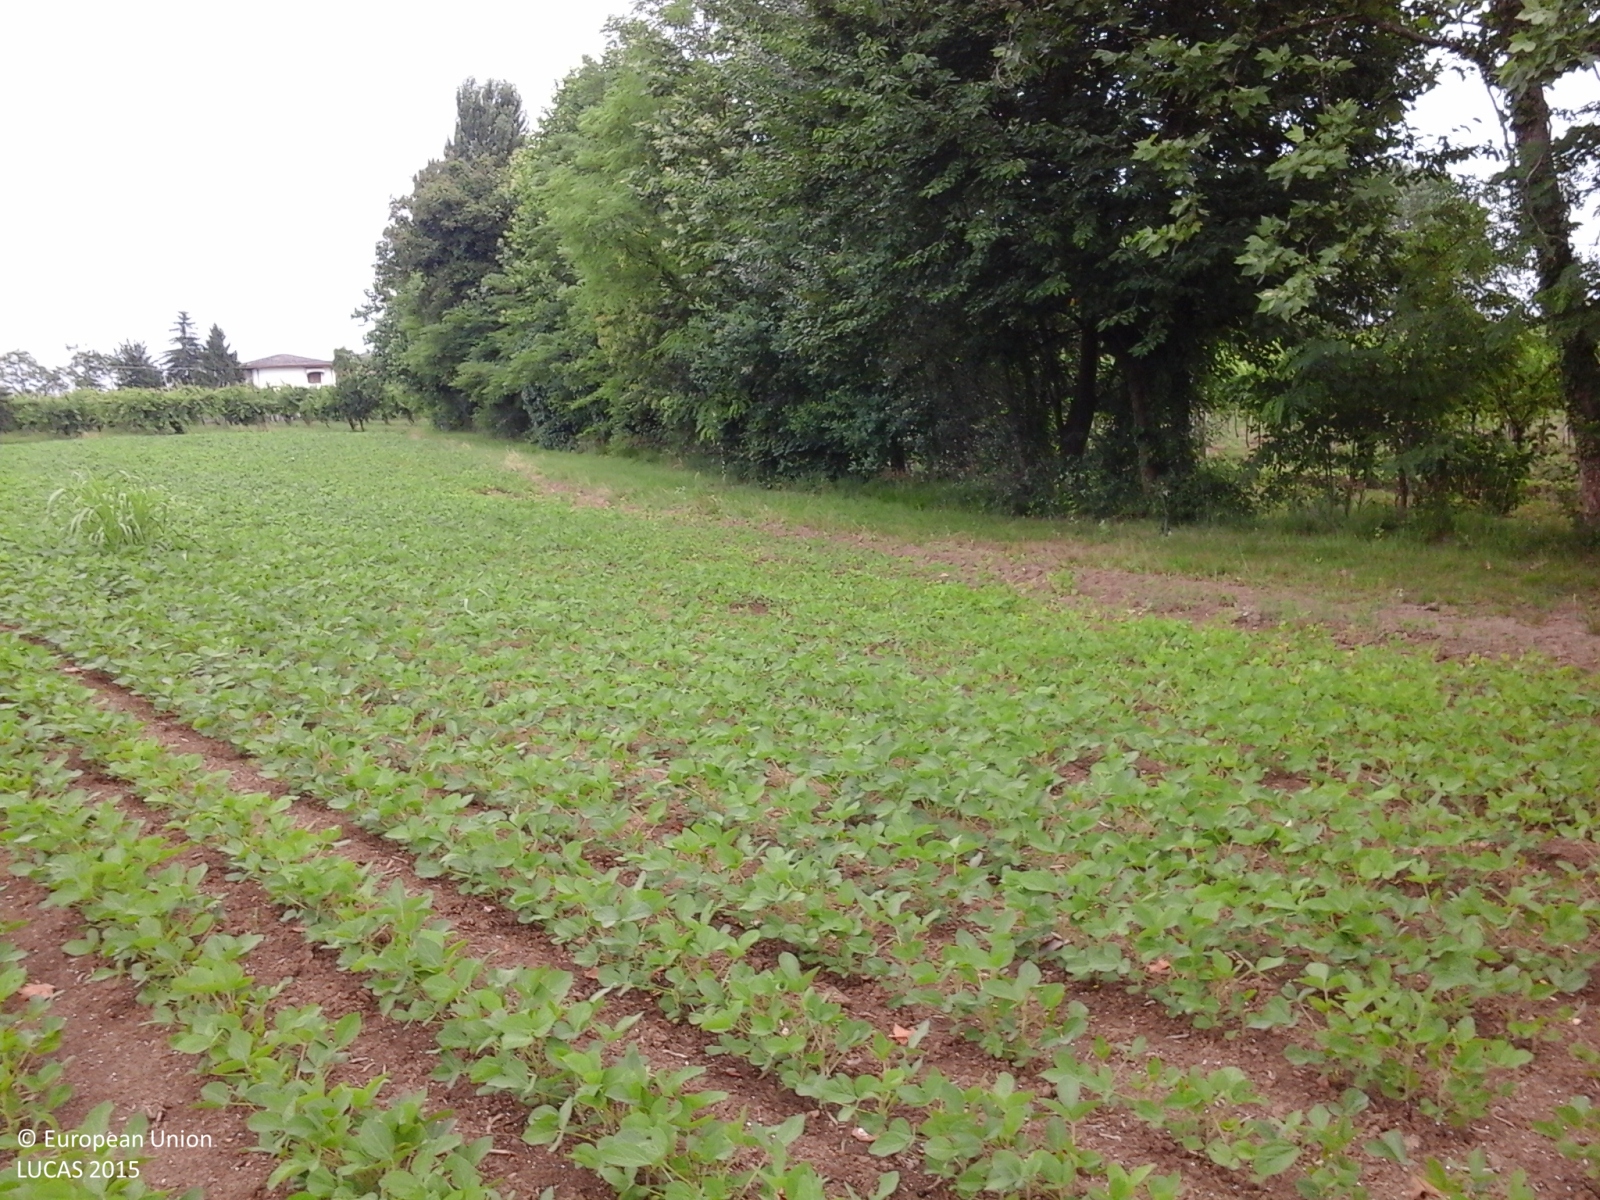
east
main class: Cropland
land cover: Soya
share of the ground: 50 - 75 %
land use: Agriculture (excluding fallow land and kitchen gardens)
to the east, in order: Soya; Grass margins; Abandoned hedges; Ditches and canals; Lines of trees; Vineyards; Lines of trees; Ditches and canals; Lines of trees; Grassland without tree/shrub cover; Abandoned hedges; Vineyards; Electric lines; Vineyards; Artificial constructions in urban areas
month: June
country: IT
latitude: 45.7986
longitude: 12.5311
